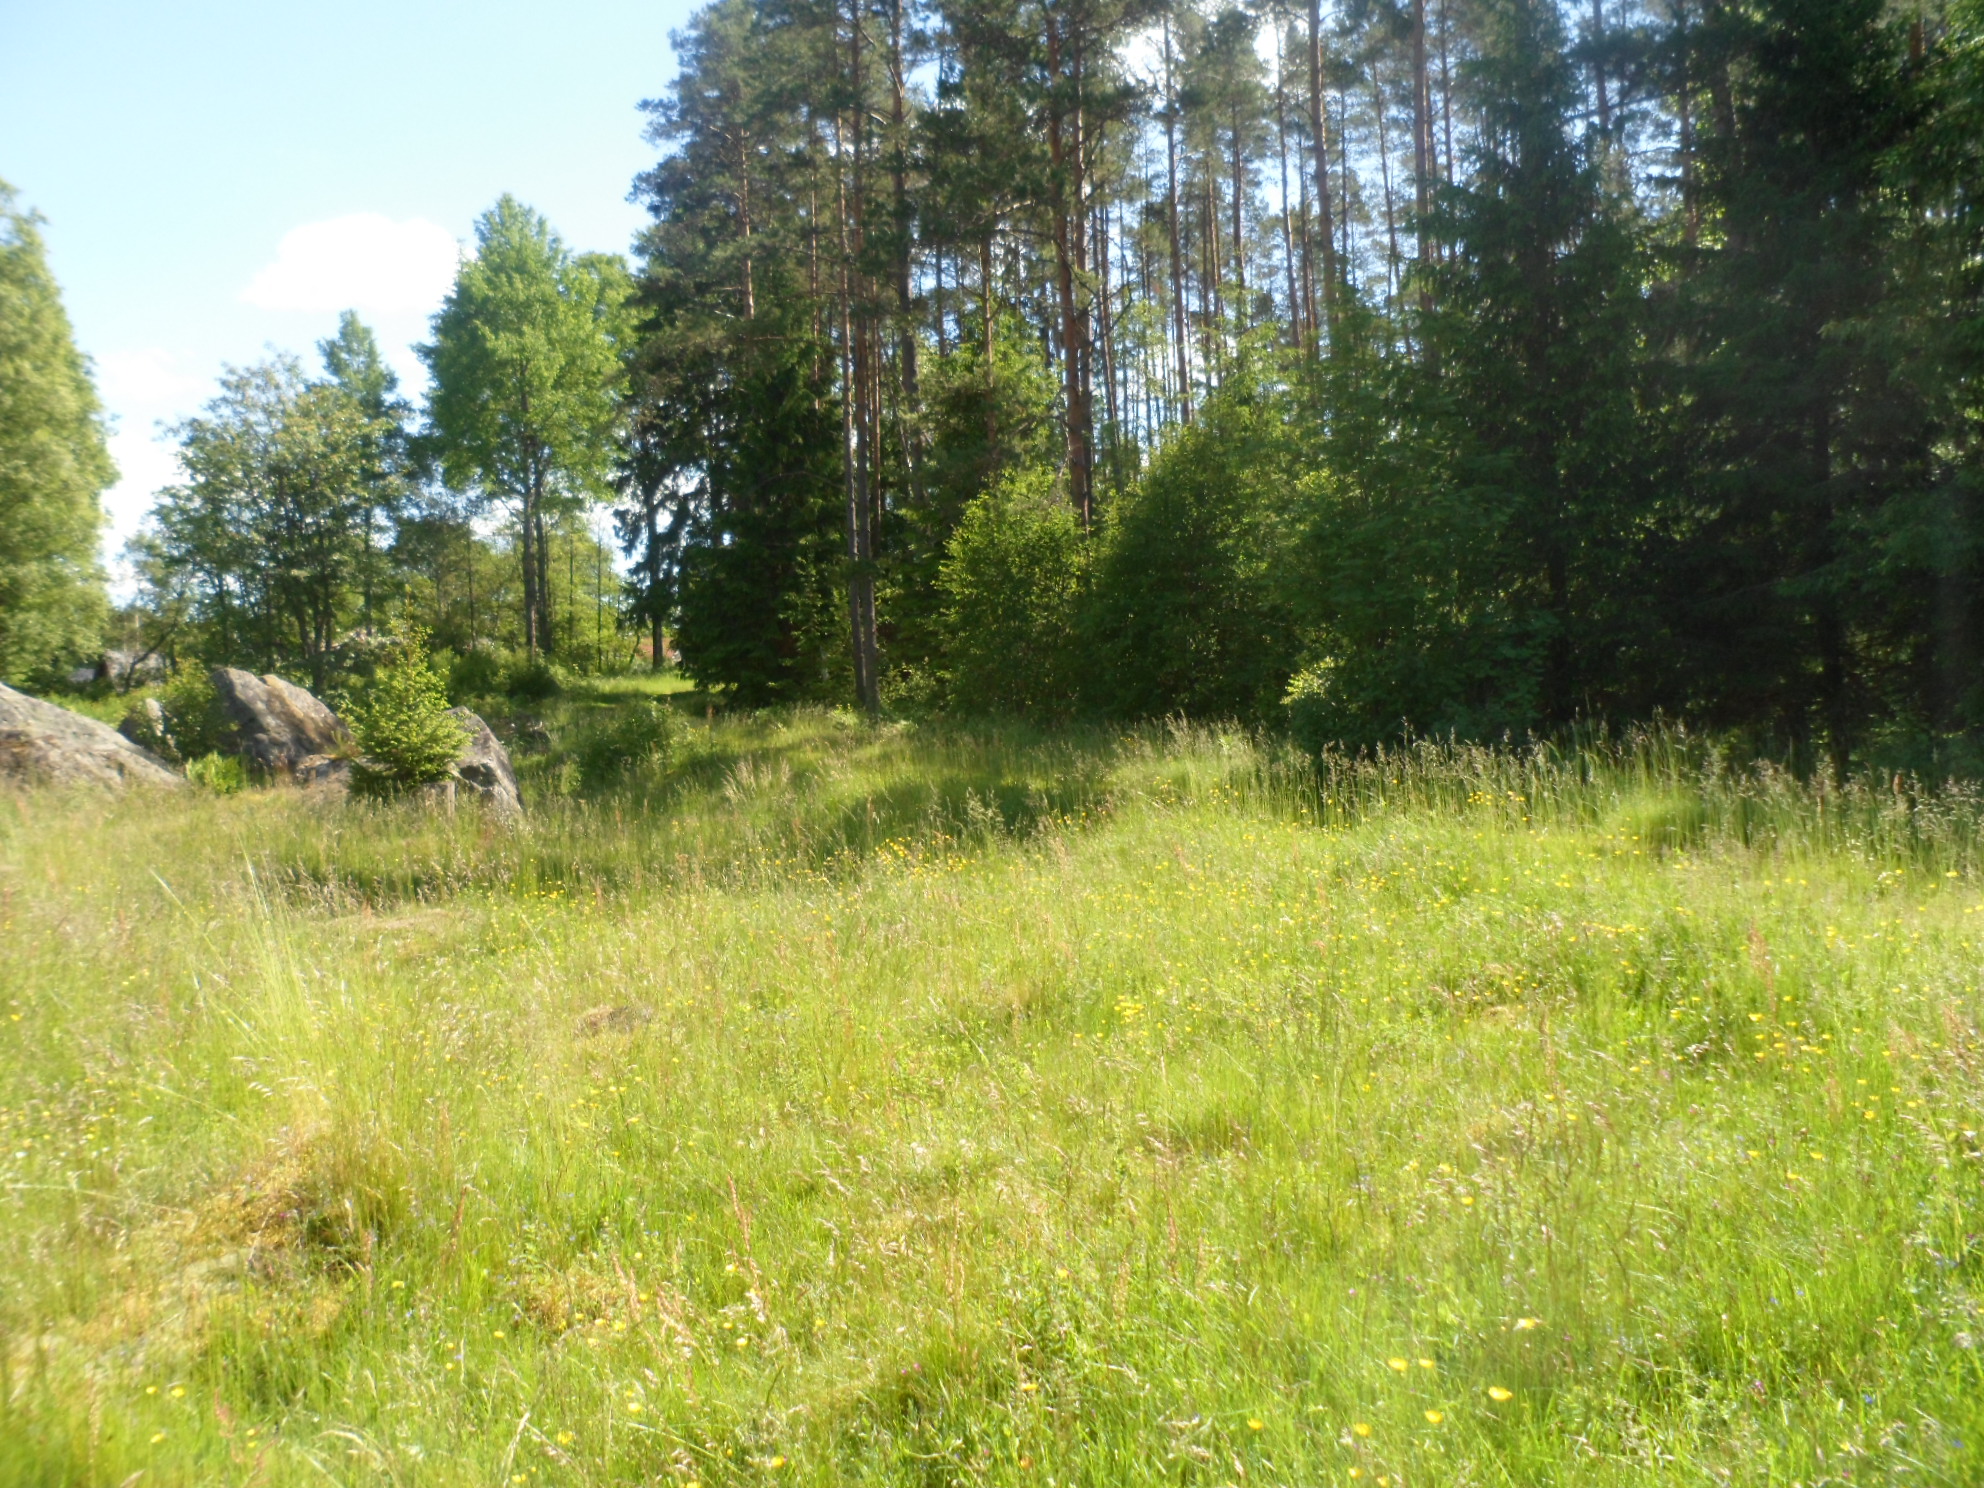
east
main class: Grassland
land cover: Grassland without tree/shrub cover
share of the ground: > 75 %
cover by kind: herbaceous plants 100 %
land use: Agriculture (excluding fallow land and kitchen gardens)
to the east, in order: Grassland without tree/shrub cover; Tracks; Pine dominated coniferous woodland; Fences; Paved roads, cycling and walking lanes; Fences; Broadleaved woodland; Spruce dominated mixed woodland; Inland fresh running water; Inland marshes; Broadleaved woodland
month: July
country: SE
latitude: 57.3695
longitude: 14.5021
